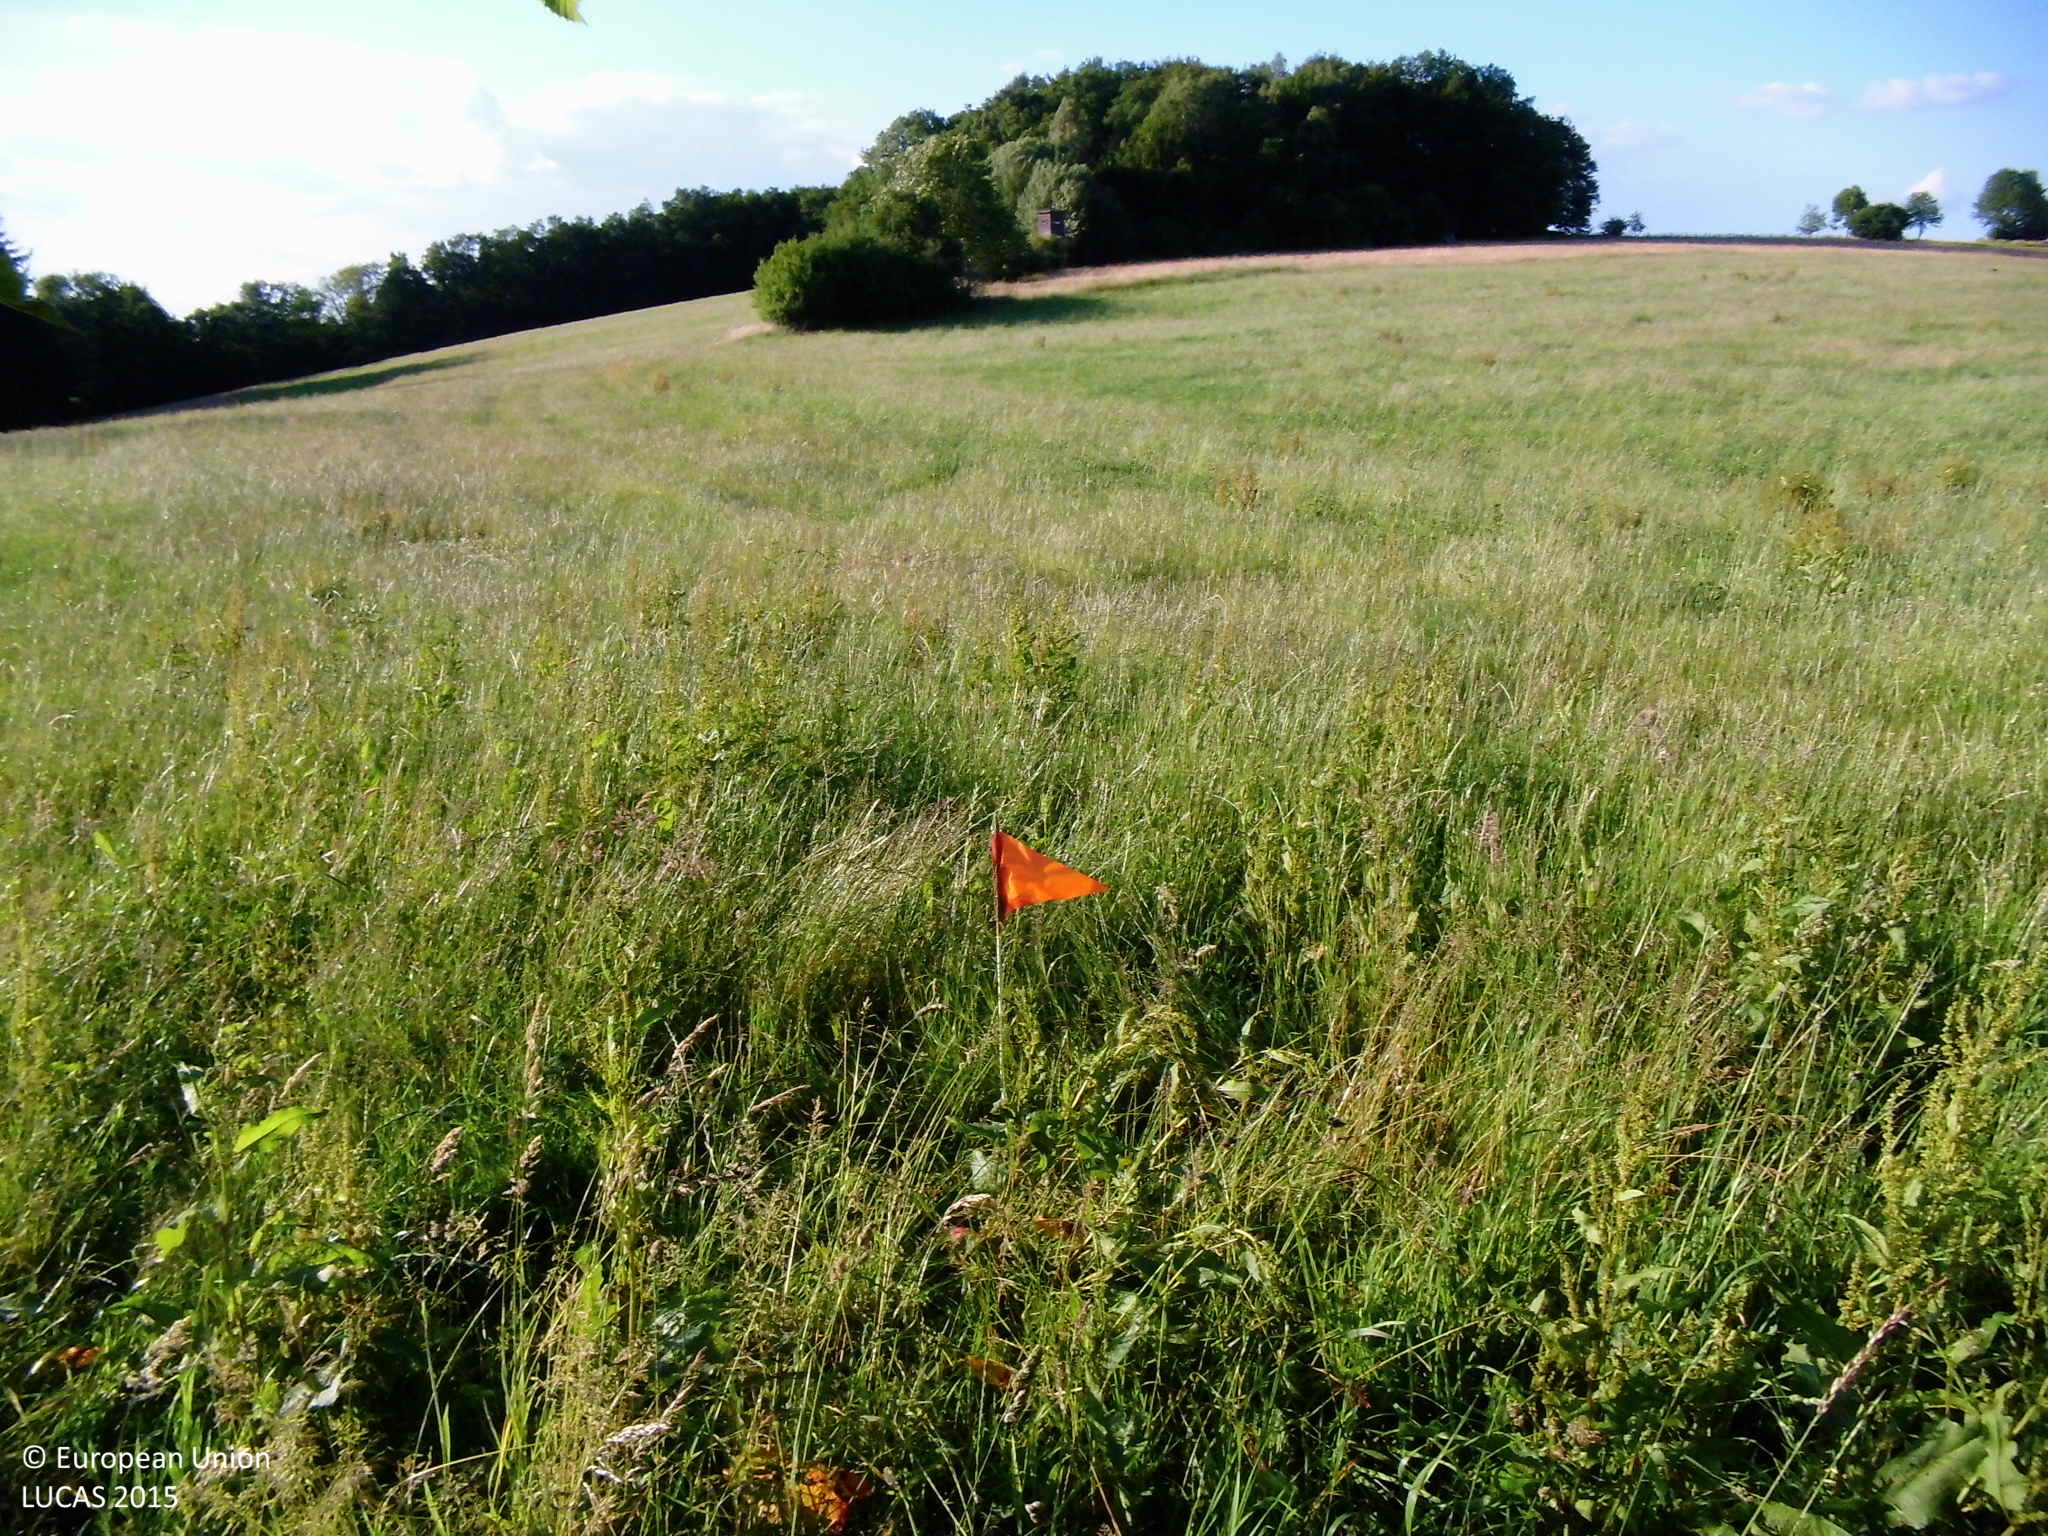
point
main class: Grassland
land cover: Grassland without tree/shrub cover
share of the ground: > 75 %
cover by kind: herbaceous plants 100 %
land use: Agriculture (excluding fallow land and kitchen gardens)
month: June
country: DE
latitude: 50.8587
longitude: 7.5141
